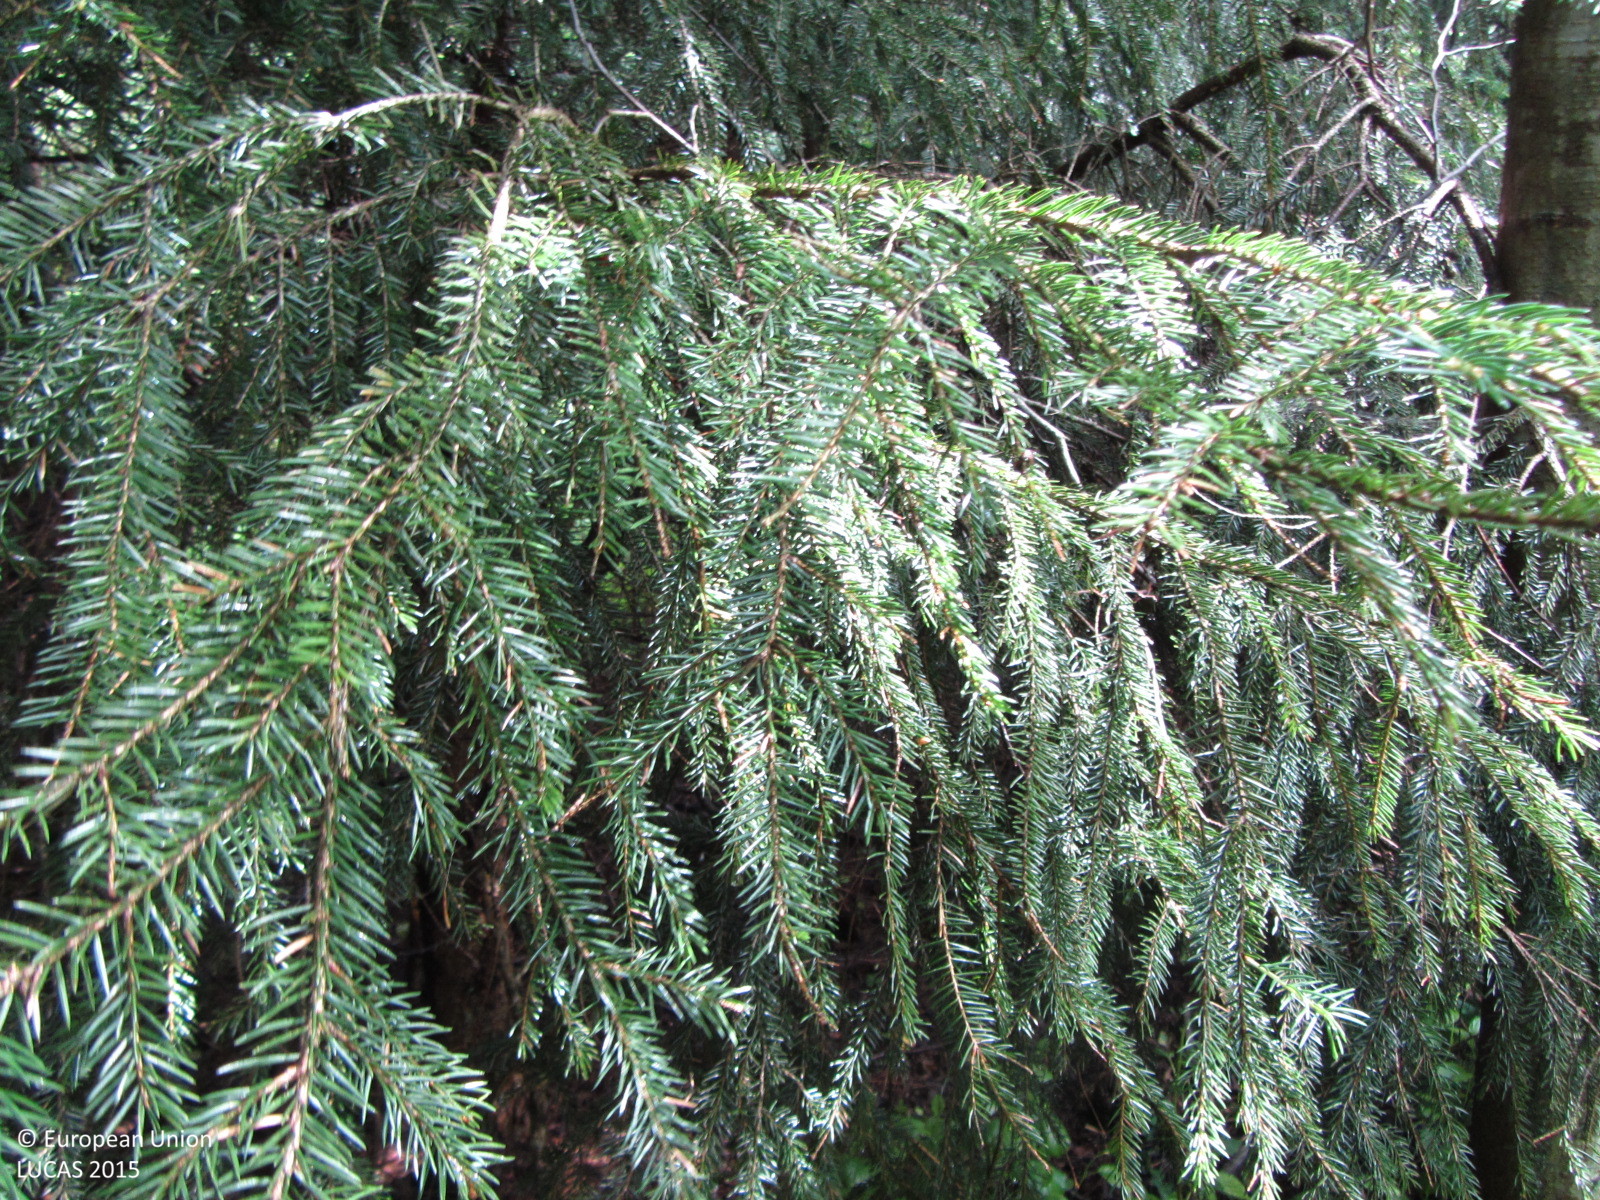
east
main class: Woodland
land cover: Spruce dominated mixed woodland
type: hemiboreal forest and nemoral coniferous forest and mixed broadleaved-coniferous forest
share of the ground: > 75 %
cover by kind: coniferous forest trees 45 %, broadleaved forest trees 45 %, herbaceous plants 10 %
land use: Forestry
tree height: > 5 m
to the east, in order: Spruce dominated mixed woodland; Grassland with sparse tree/shrub cover; Spruce dominated mixed woodland; Ditches and canals; Grass margins; Tracks; Spruce dominated mixed woodland; Artificial constructions in urban areas; Spruce dominated mixed woodland
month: July
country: FI
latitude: 60.1593
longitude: 24.5043
